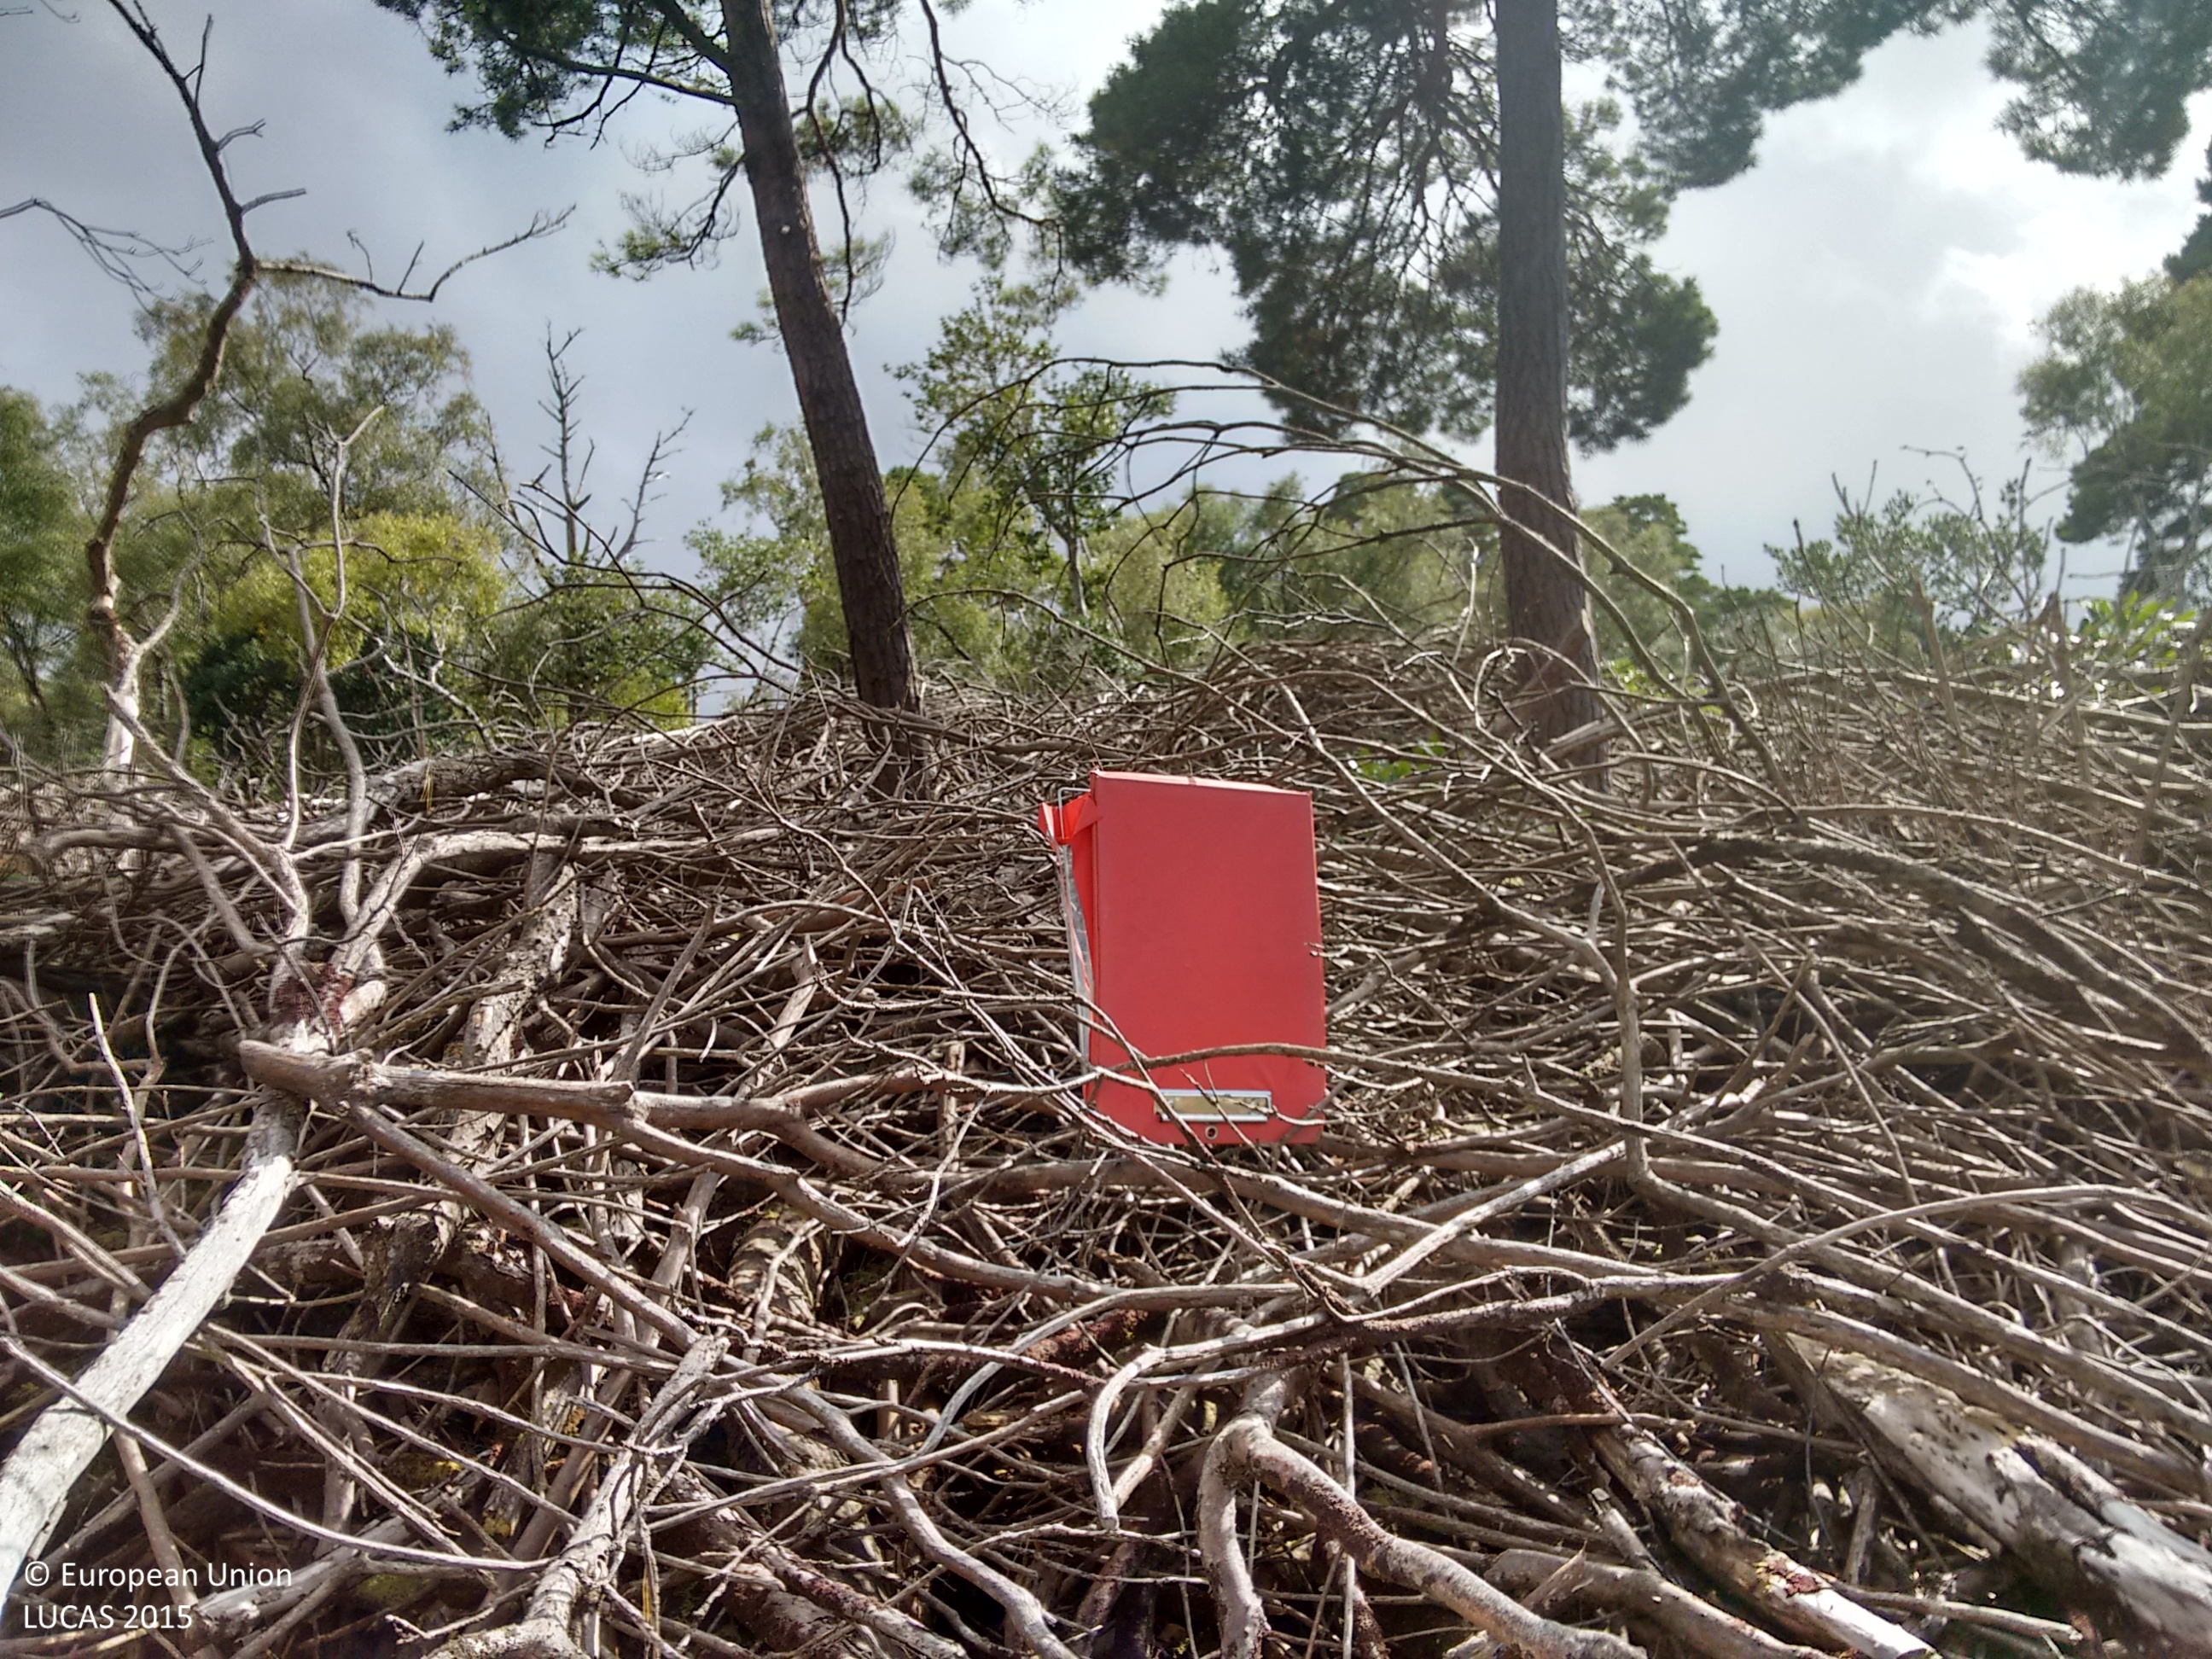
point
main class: Woodland
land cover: Pine dominated mixed woodland
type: exotic forest
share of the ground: > 75 %
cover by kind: coniferous forest trees 40 %, broadleaved forest trees 20 %, unconsolidated bare surface 15 %, herbaceous plants 10 %
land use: Amenities, museums, leisure
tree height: > 5 m
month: August
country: IE
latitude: 52.0478
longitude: -9.5252
